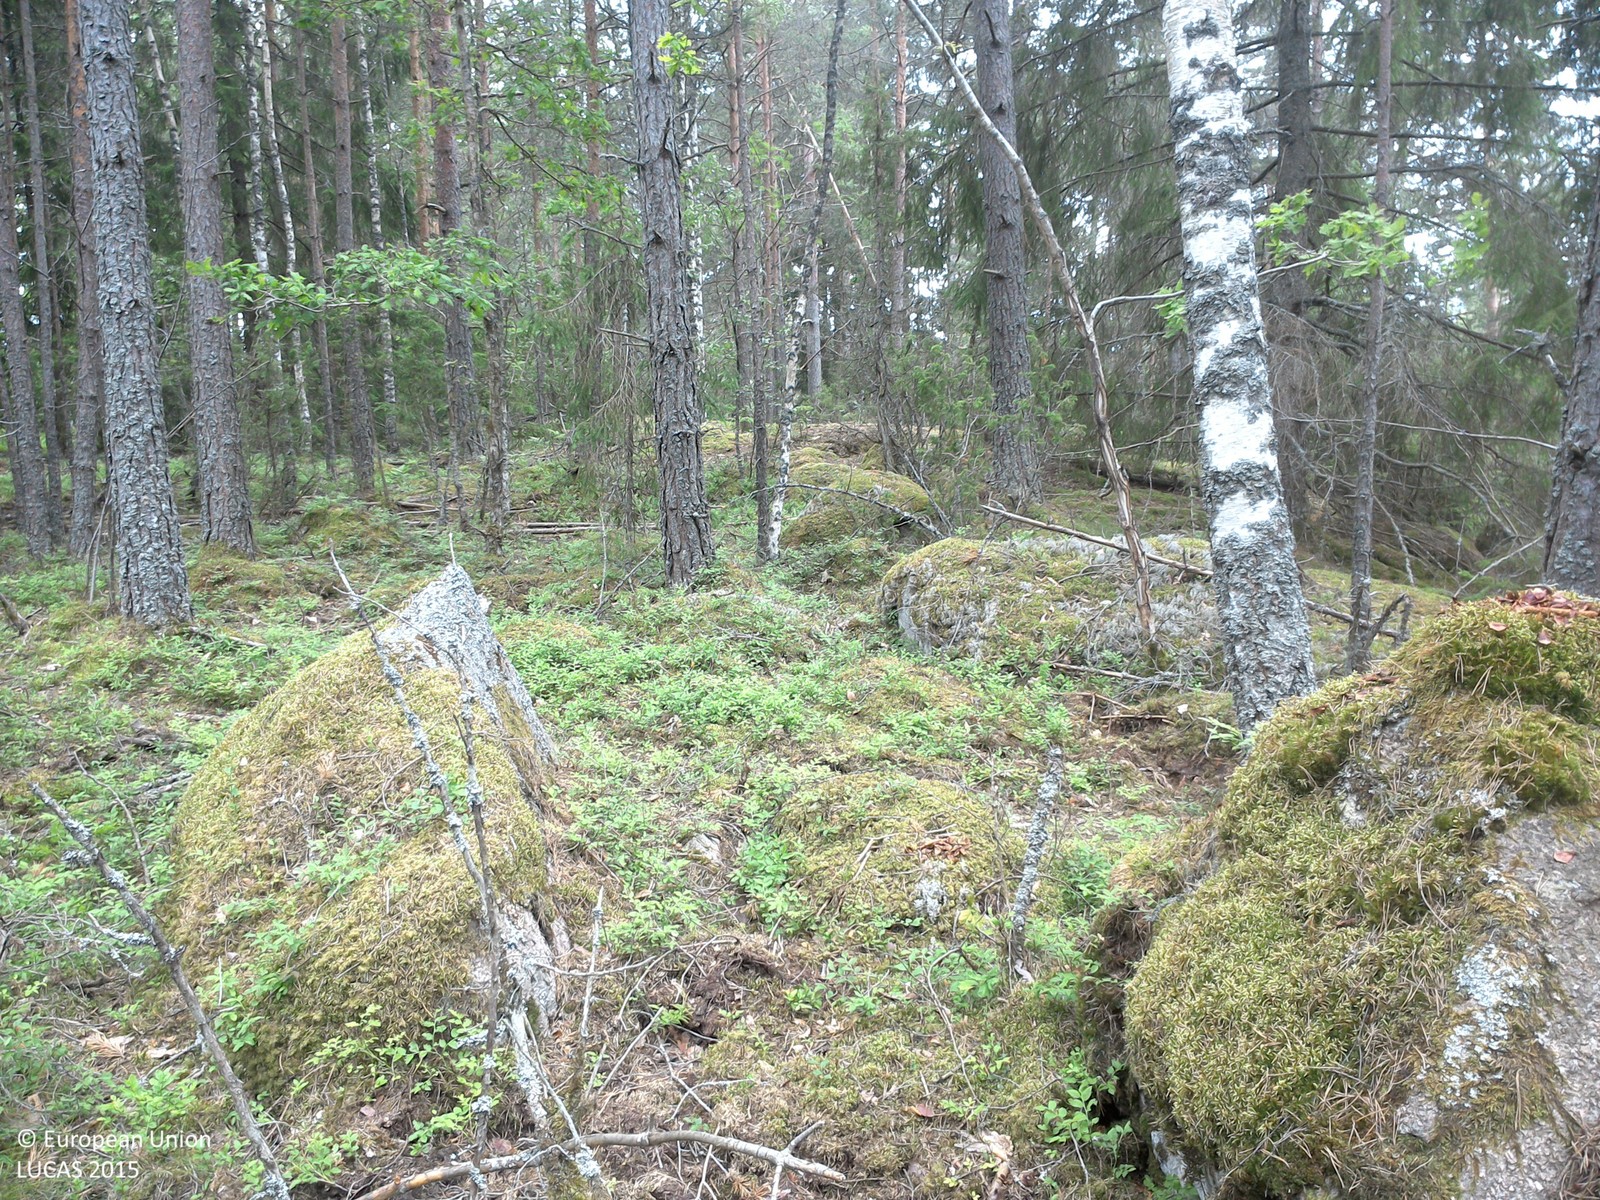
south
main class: Woodland
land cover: Pine dominated coniferous woodland
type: boreal forest
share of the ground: 50 - 75 %
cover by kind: coniferous forest trees 60 %, herbaceous plants 20 %, lichens and mosses 20 %
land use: Agriculture (excluding fallow land and kitchen gardens)
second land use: Forestry
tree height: > 5 m
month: June
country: SE
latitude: 58.3037
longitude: 15.5406
